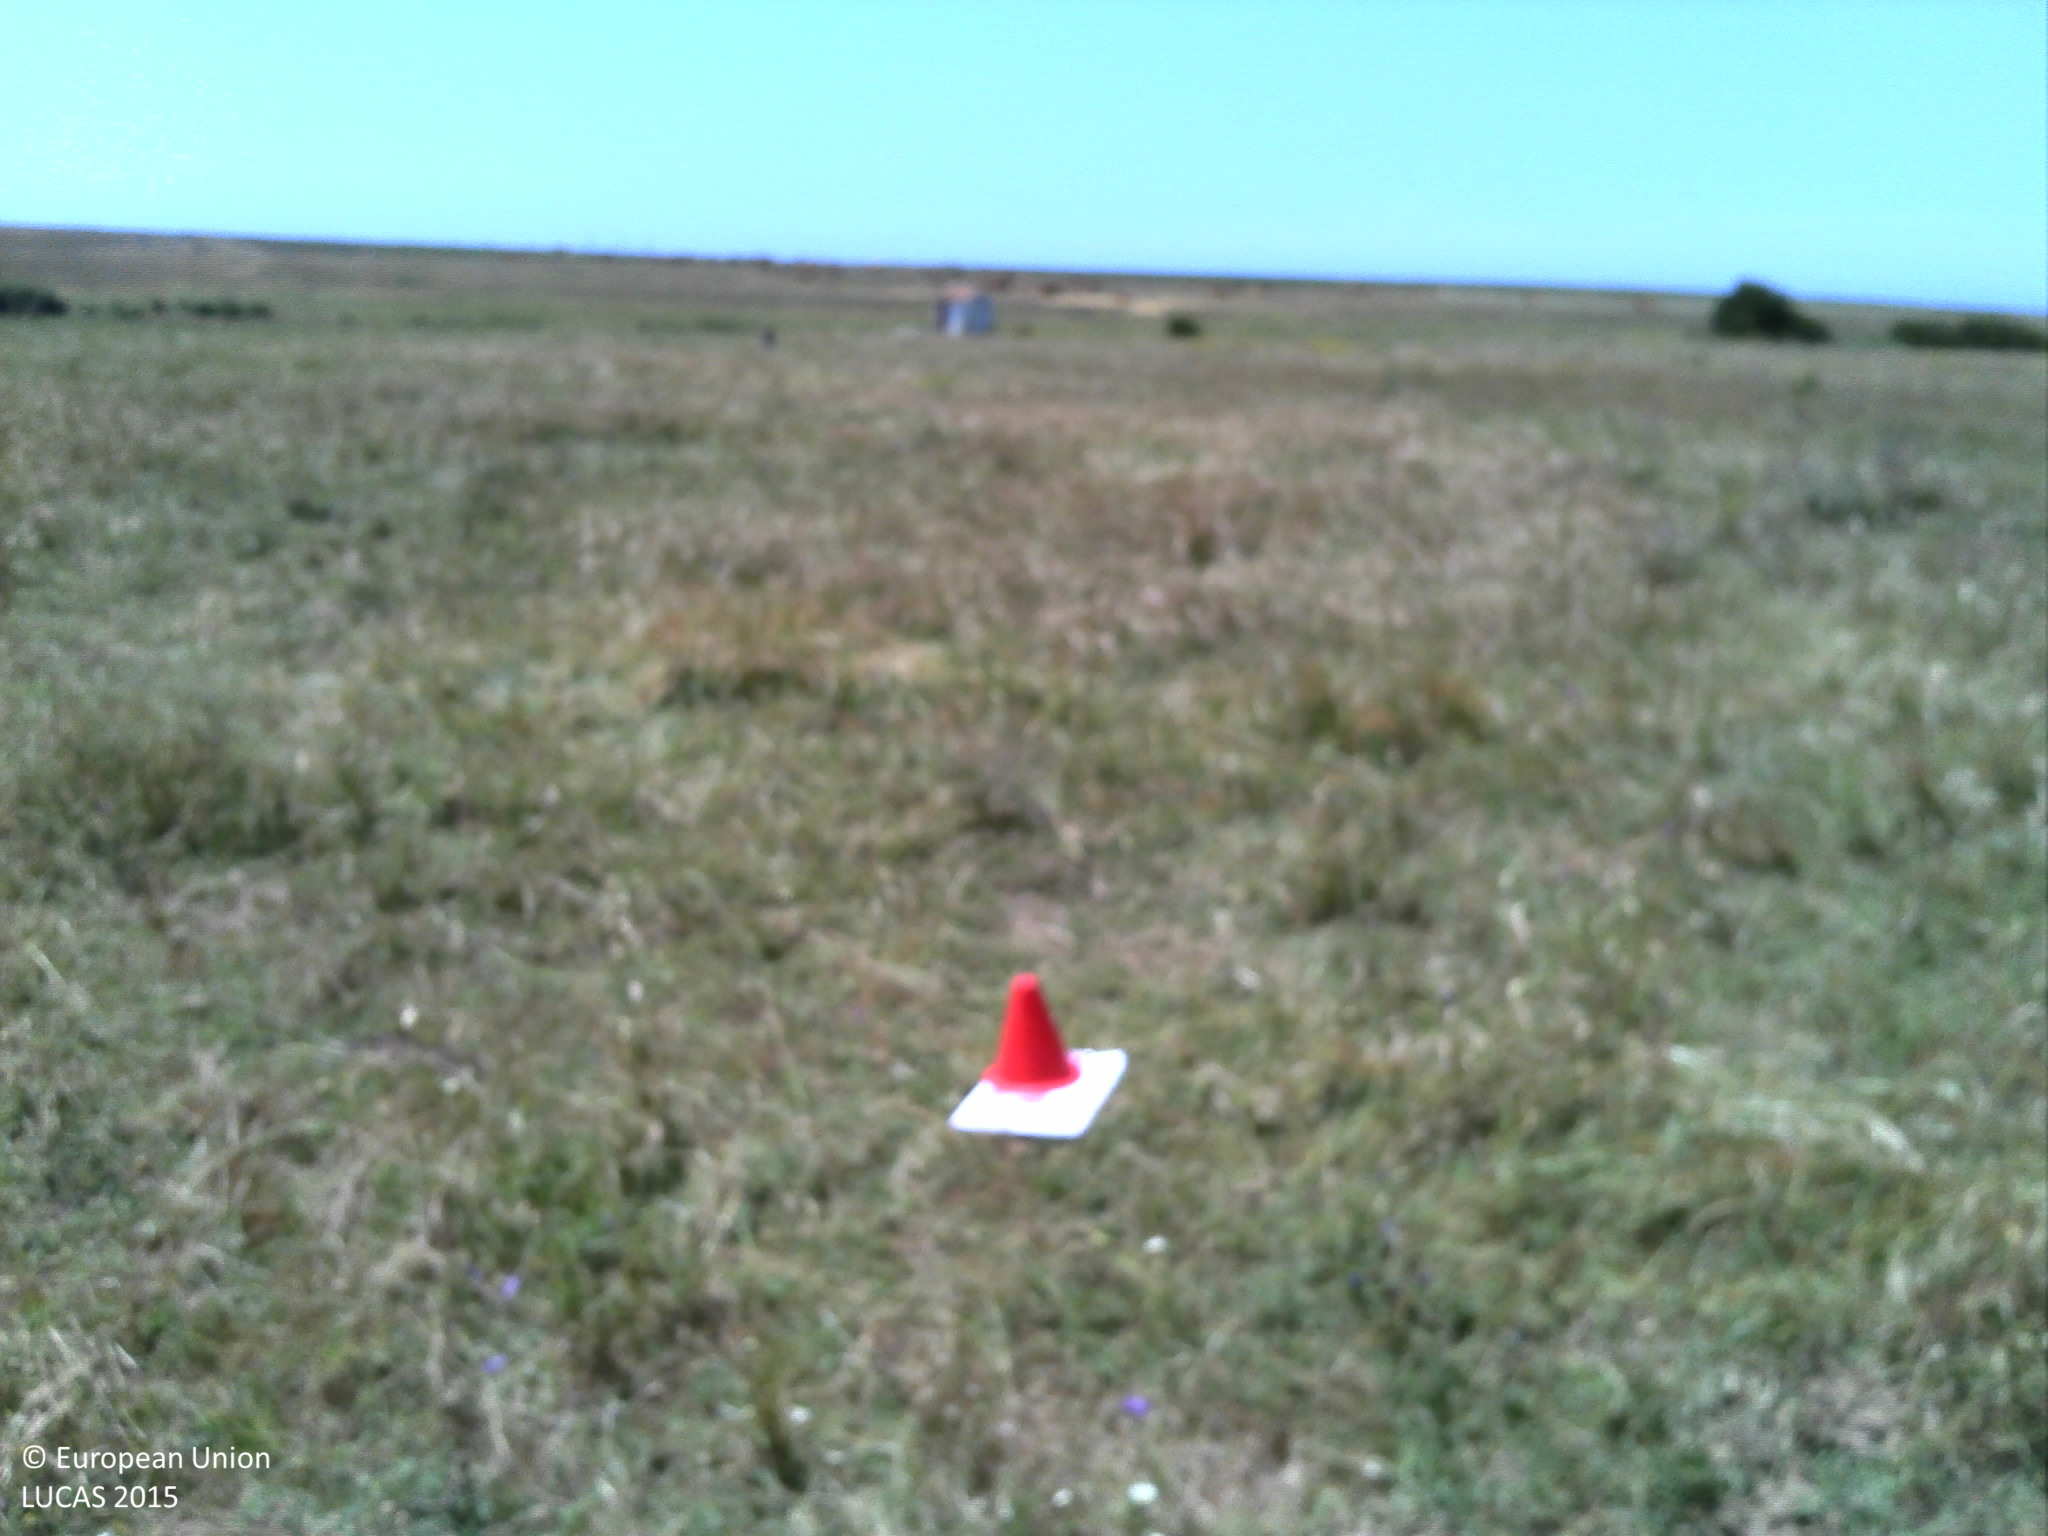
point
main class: Grassland
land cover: Grassland without tree/shrub cover
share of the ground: > 75 %
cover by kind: herbaceous plants 80 %, consolidated bare surface 15 %, shrubs 5 %
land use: Agriculture (excluding fallow land and kitchen gardens)
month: May
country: PT
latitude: 37.5649
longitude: -8.7778
